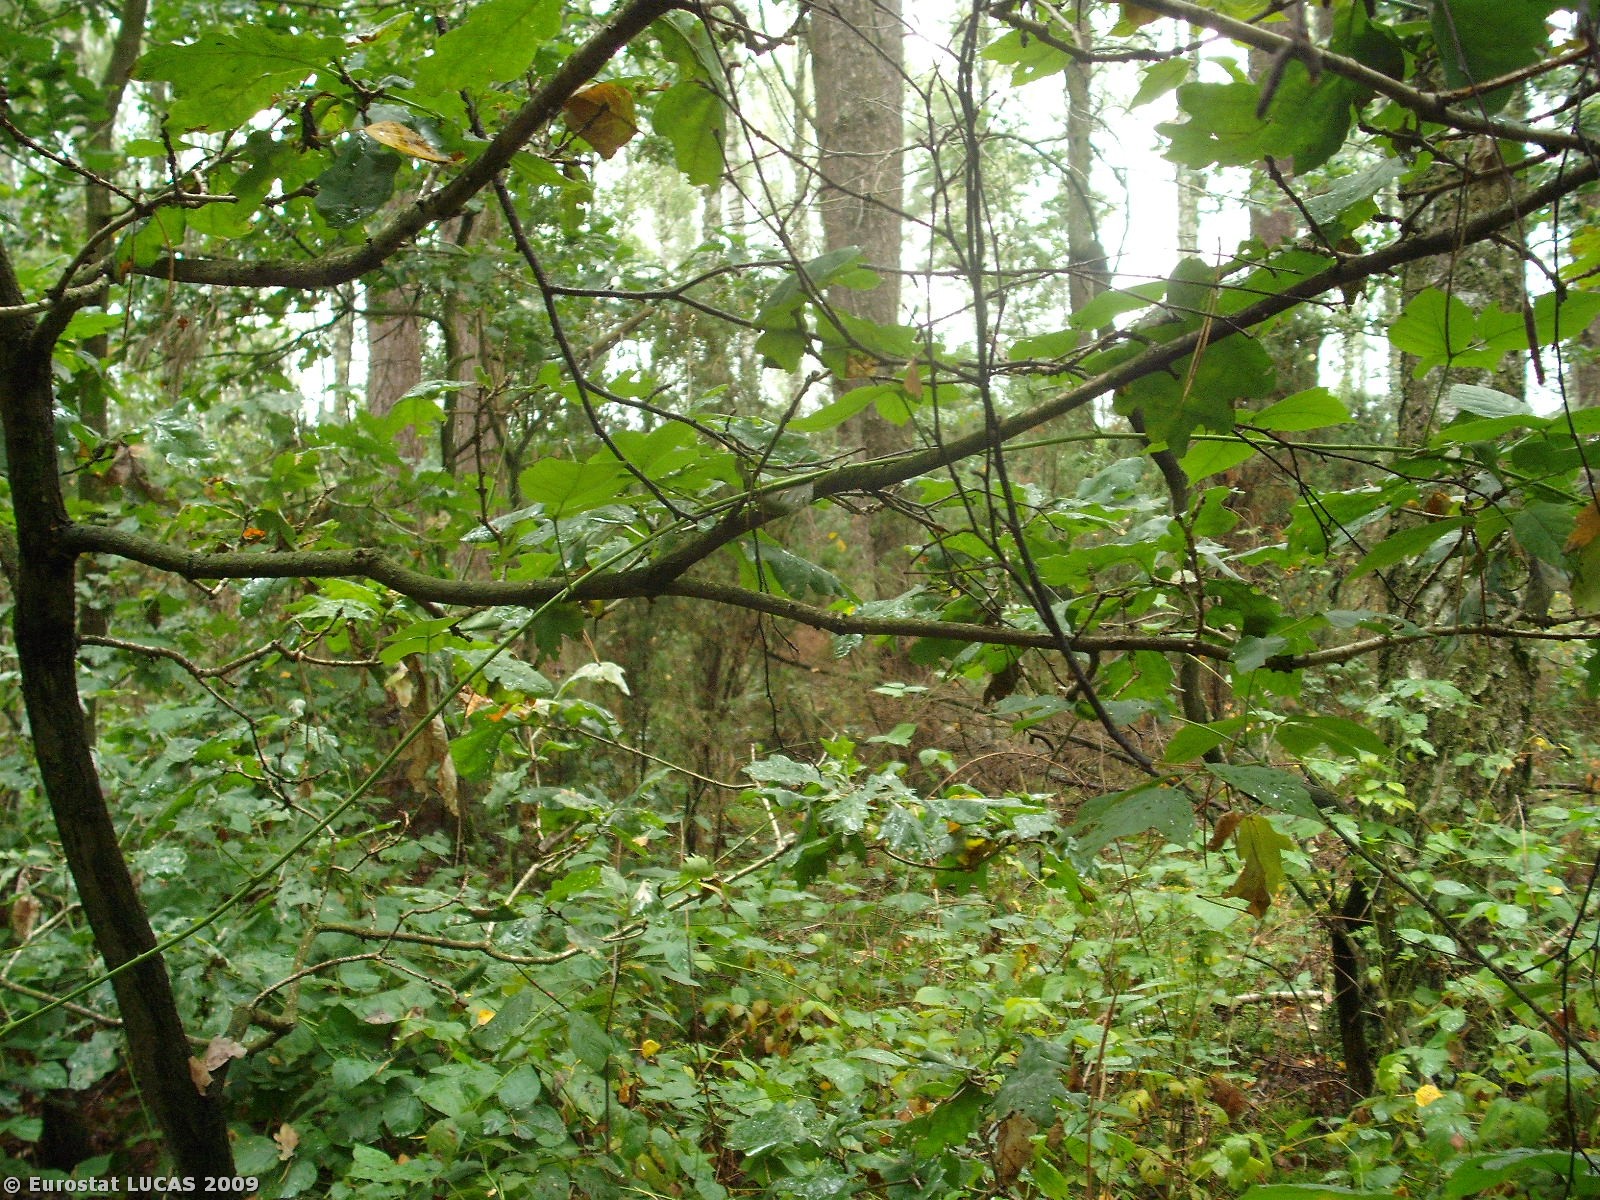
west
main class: Woodland
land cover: Mixed woodland
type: hemiboreal forest and nemoral coniferous forest and mixed broadleaved-coniferous forest
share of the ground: > 75 %
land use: Forestry
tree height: > 5 m
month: September
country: PL
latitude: 51.7175
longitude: 22.1177
